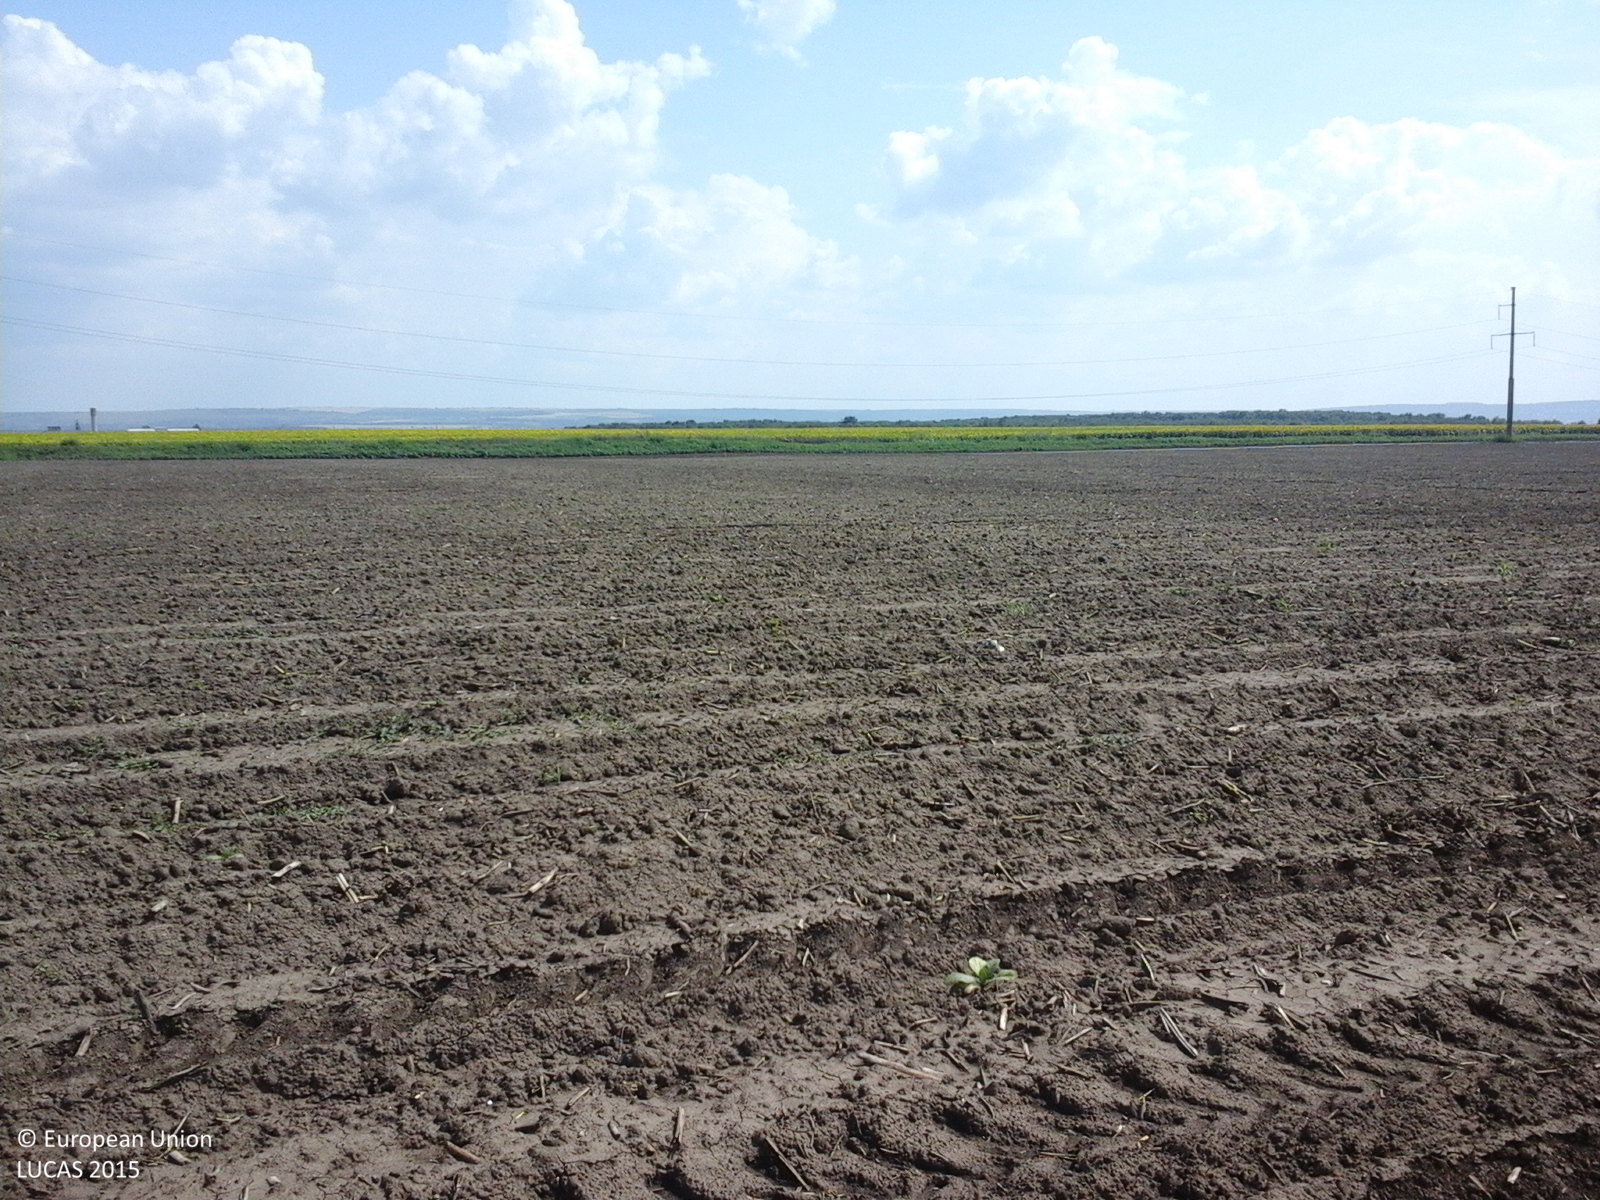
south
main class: Cropland
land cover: Tobacco
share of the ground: < 10 %
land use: Agriculture (excluding fallow land and kitchen gardens)
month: July
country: RO
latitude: 43.6837
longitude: 25.4271
